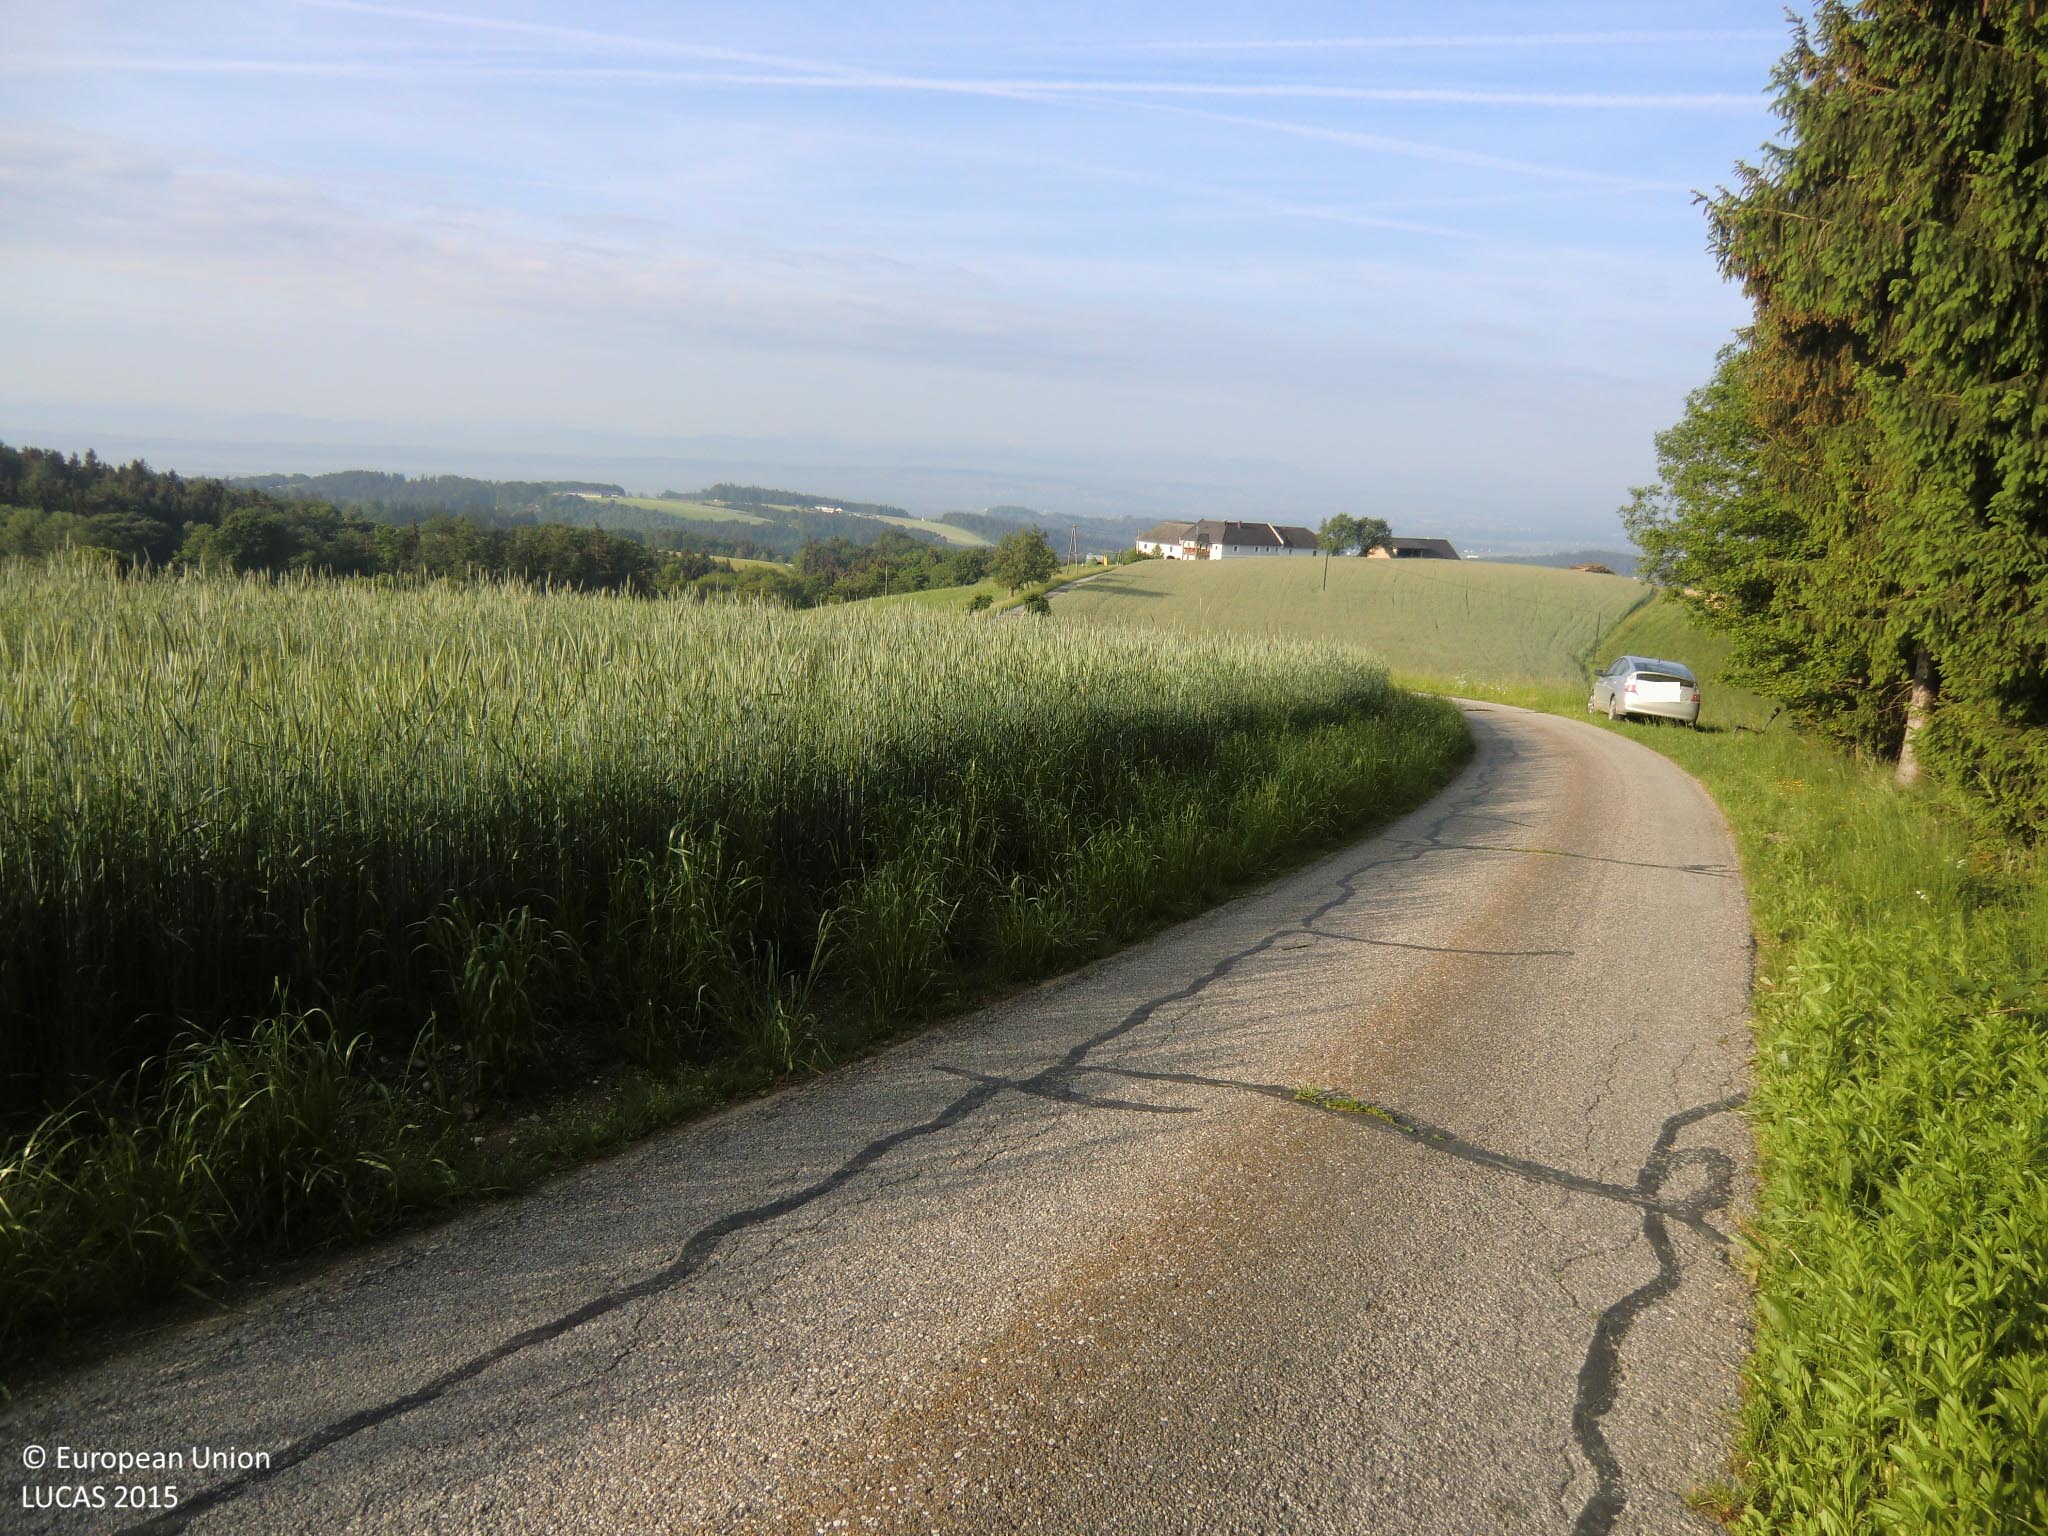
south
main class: Woodland
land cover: Spruce dominated mixed woodland
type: hemiboreal forest and nemoral coniferous forest and mixed broadleaved-coniferous forest
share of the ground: > 75 %
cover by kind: coniferous forest trees 40 %, broadleaved forest trees 40 %, herbaceous plants 20 %
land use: Forestry
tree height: > 5 m
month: May
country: AT
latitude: 48.2888
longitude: 14.6235
